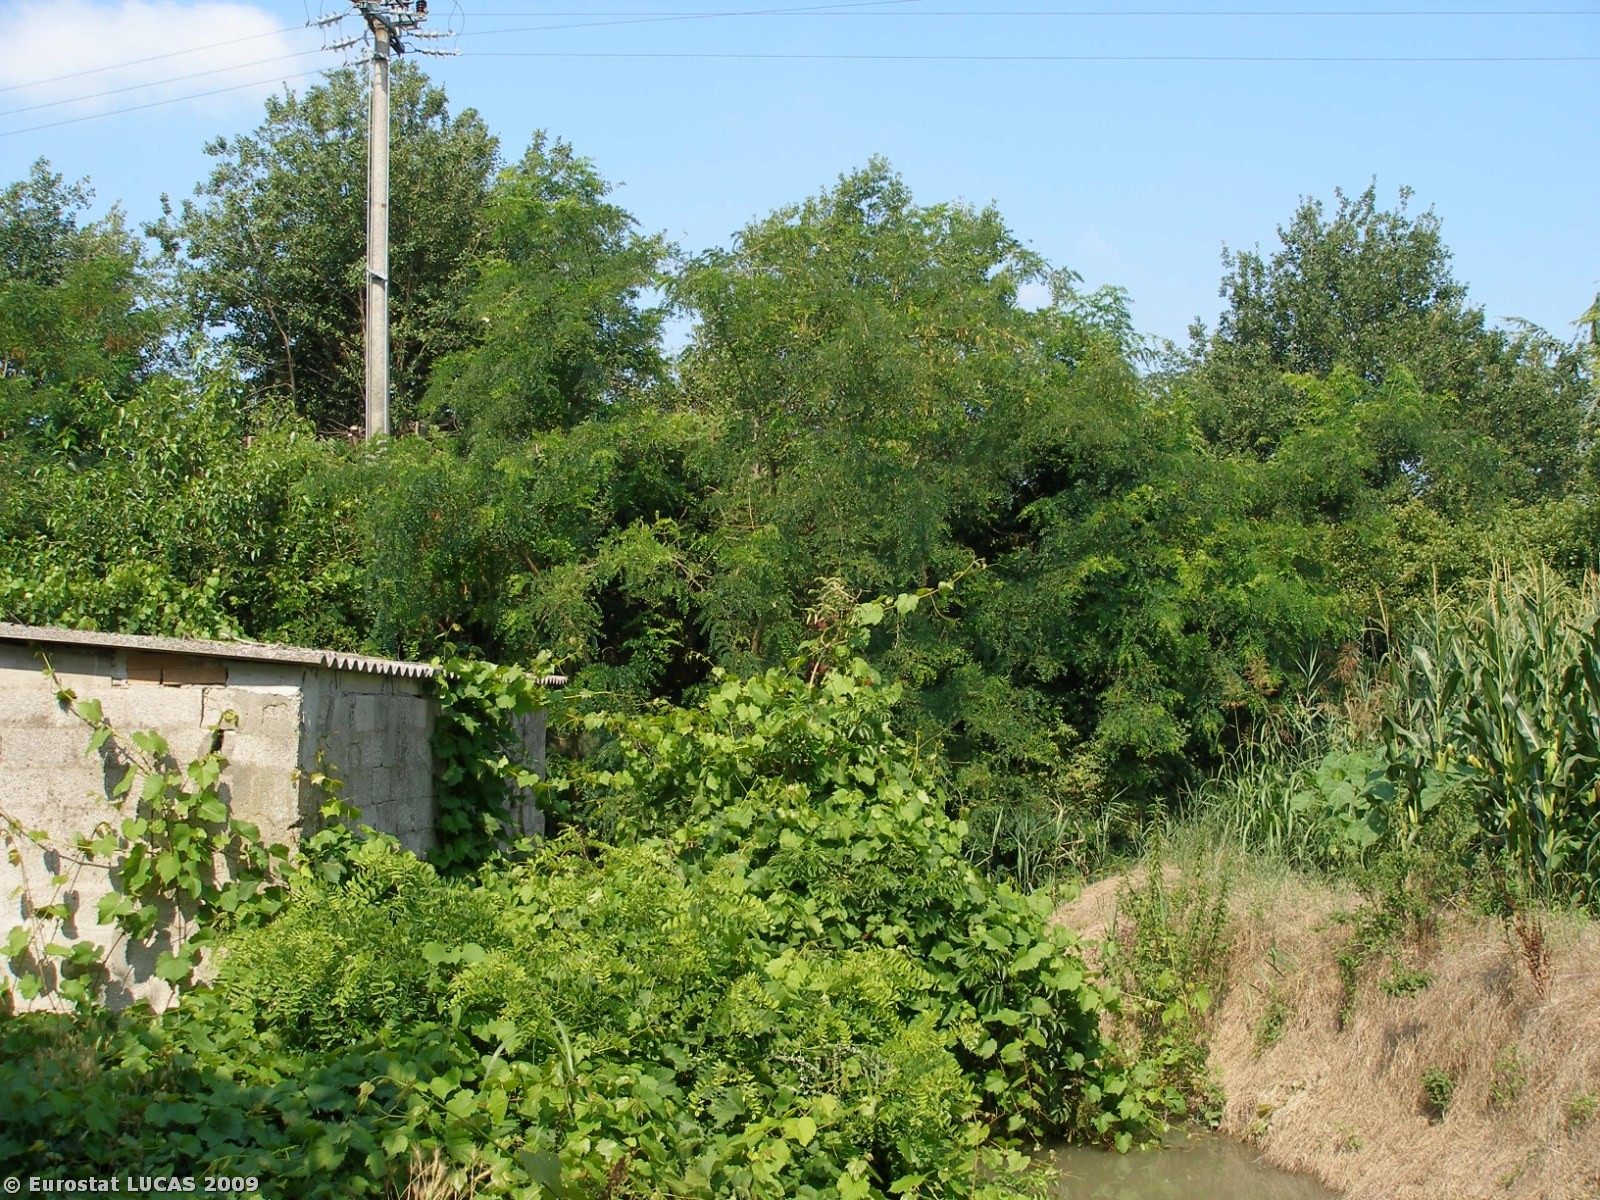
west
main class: Woodland
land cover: Broadleaved woodland
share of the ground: > 75 %
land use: Residential
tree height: > 5 m
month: July
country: IT
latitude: 45.0767
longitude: 11.6610
